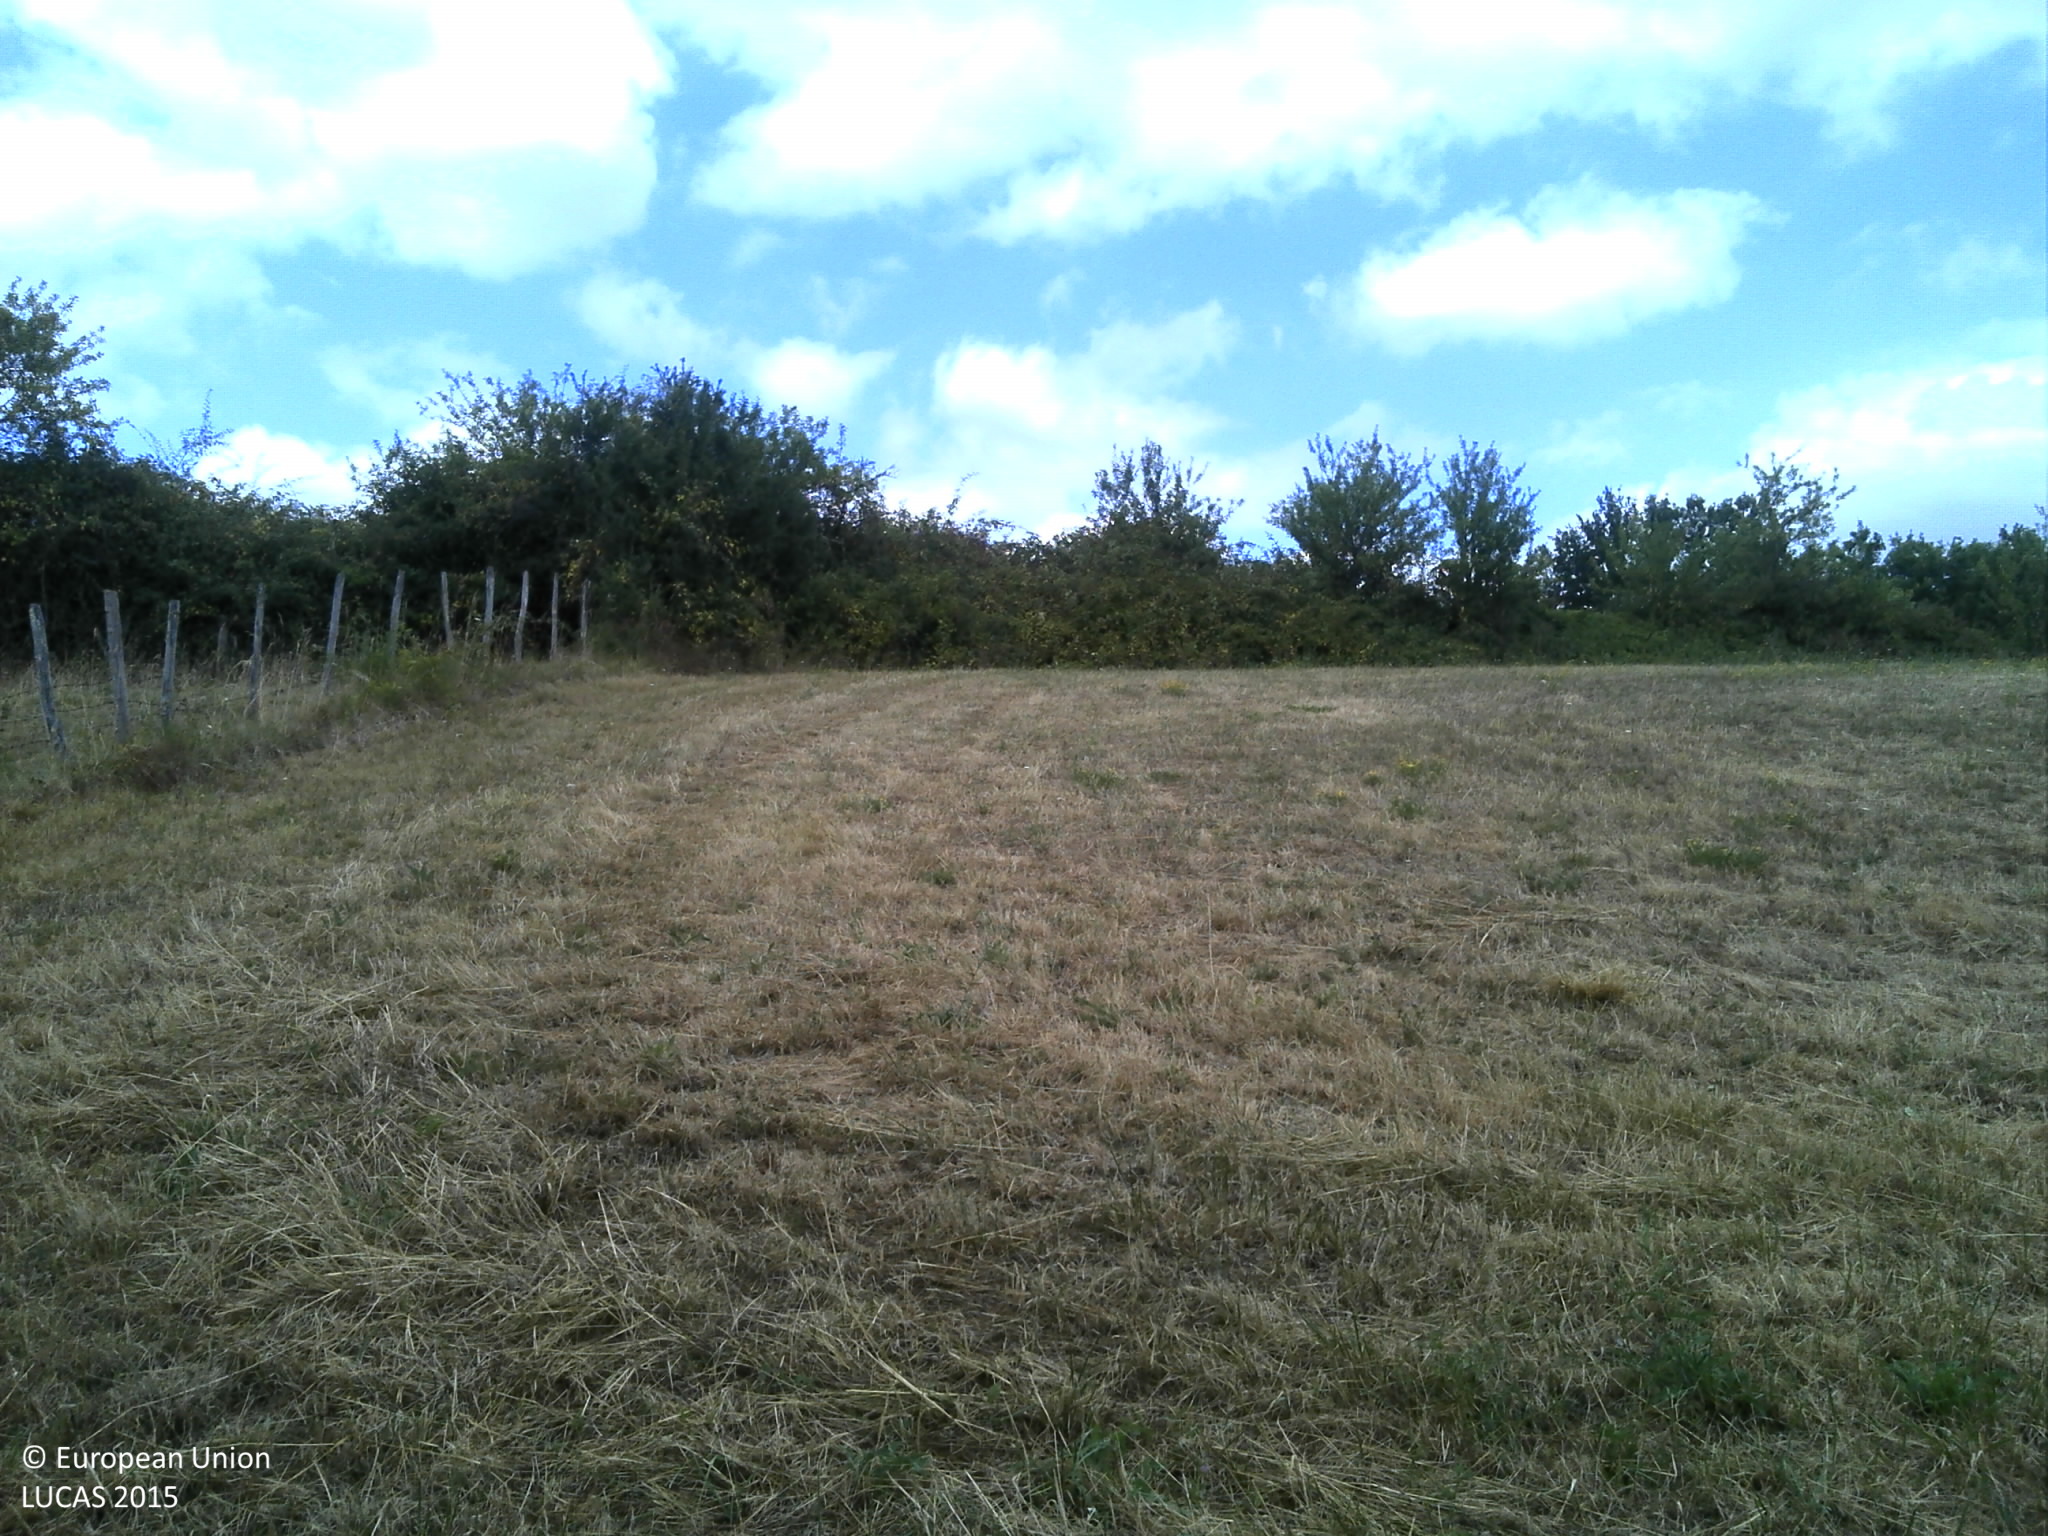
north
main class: Grassland
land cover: Grassland without tree/shrub cover
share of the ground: > 75 %
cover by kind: herbaceous plants 100 %
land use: Agriculture (excluding fallow land and kitchen gardens)
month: July
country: FR
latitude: 44.9513
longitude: 1.8222
